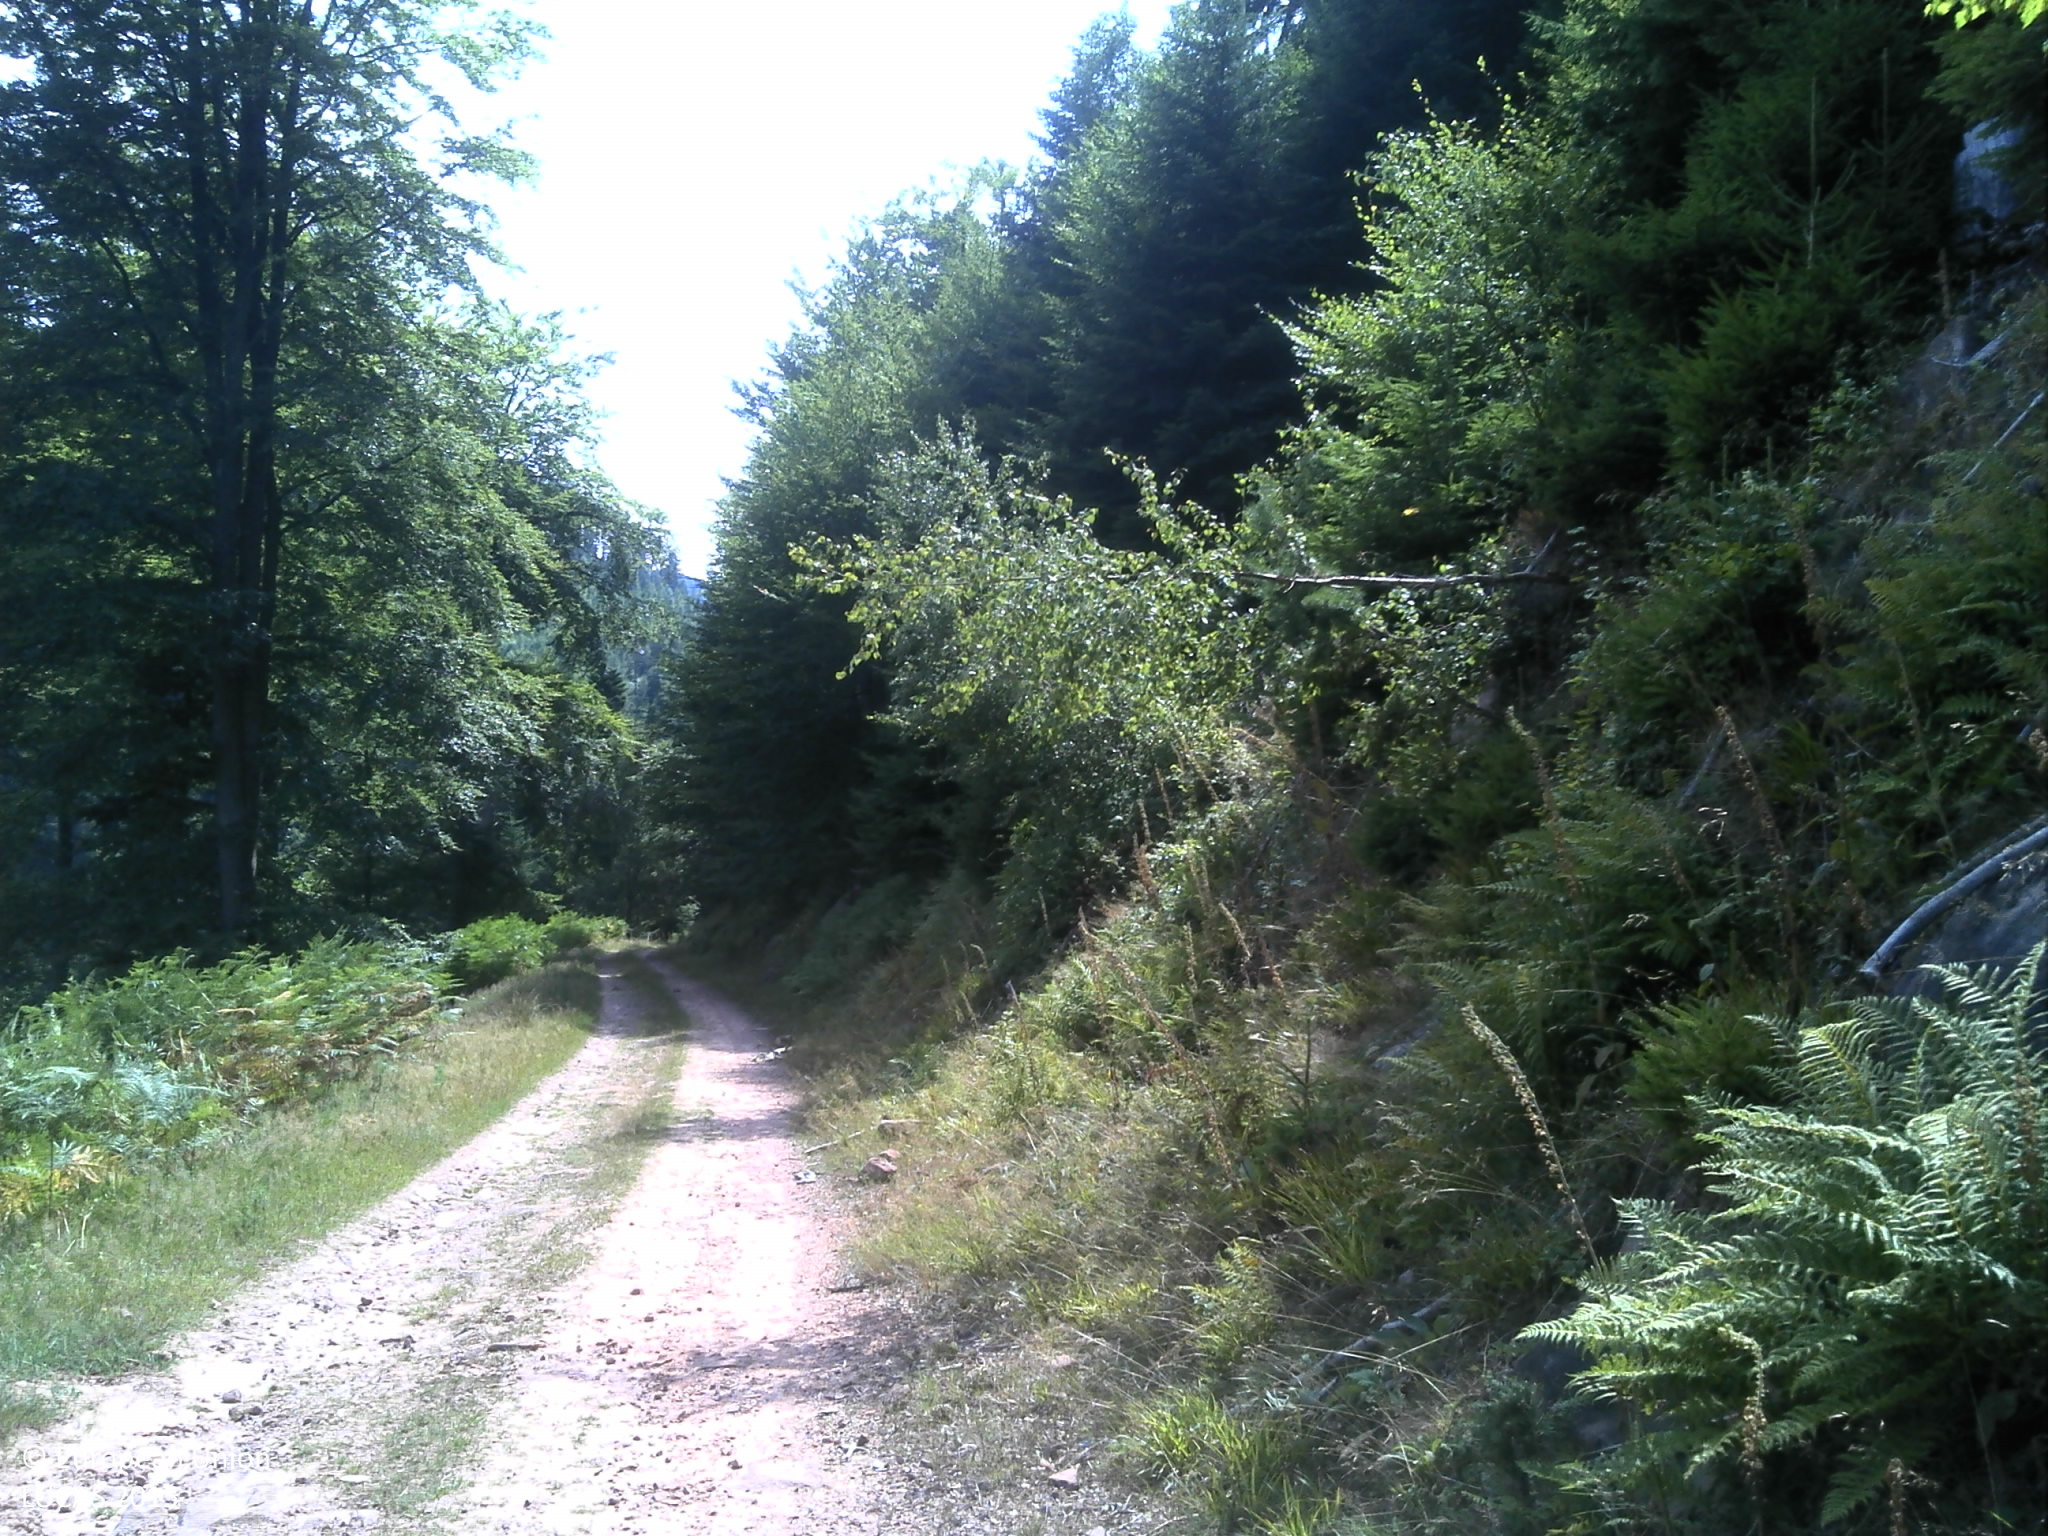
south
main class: Woodland
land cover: Spruce dominated mixed woodland
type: hemiboreal forest and nemoral coniferous forest and mixed broadleaved-coniferous forest
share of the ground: > 75 %
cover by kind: coniferous forest trees 40 %, broadleaved forest trees 40 %, shrubs 10 %, herbaceous plants 10 %
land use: Forestry
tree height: > 5 m
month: July
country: FR
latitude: 48.6219
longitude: 7.2739
